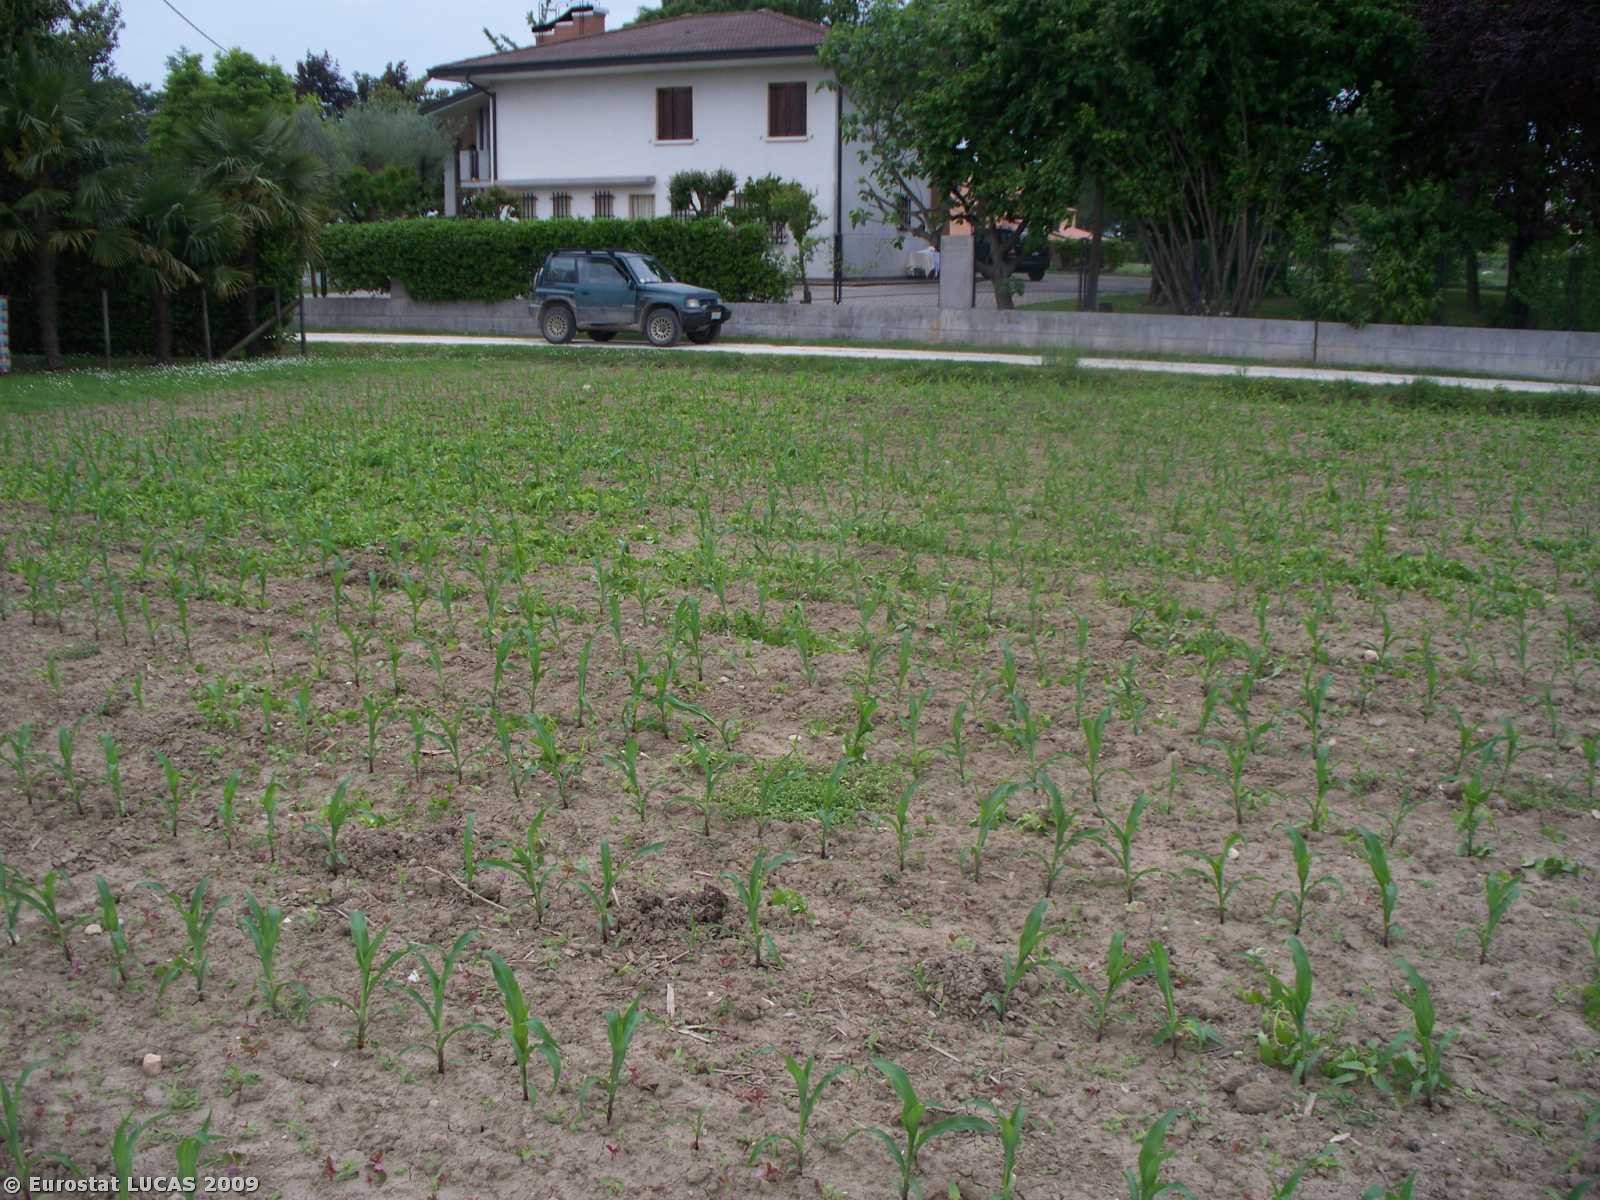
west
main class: Cropland
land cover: Maize
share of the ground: < 10 %
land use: Agriculture (excluding fallow land and kitchen gardens)
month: May
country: IT
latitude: 45.6881
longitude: 12.6286
